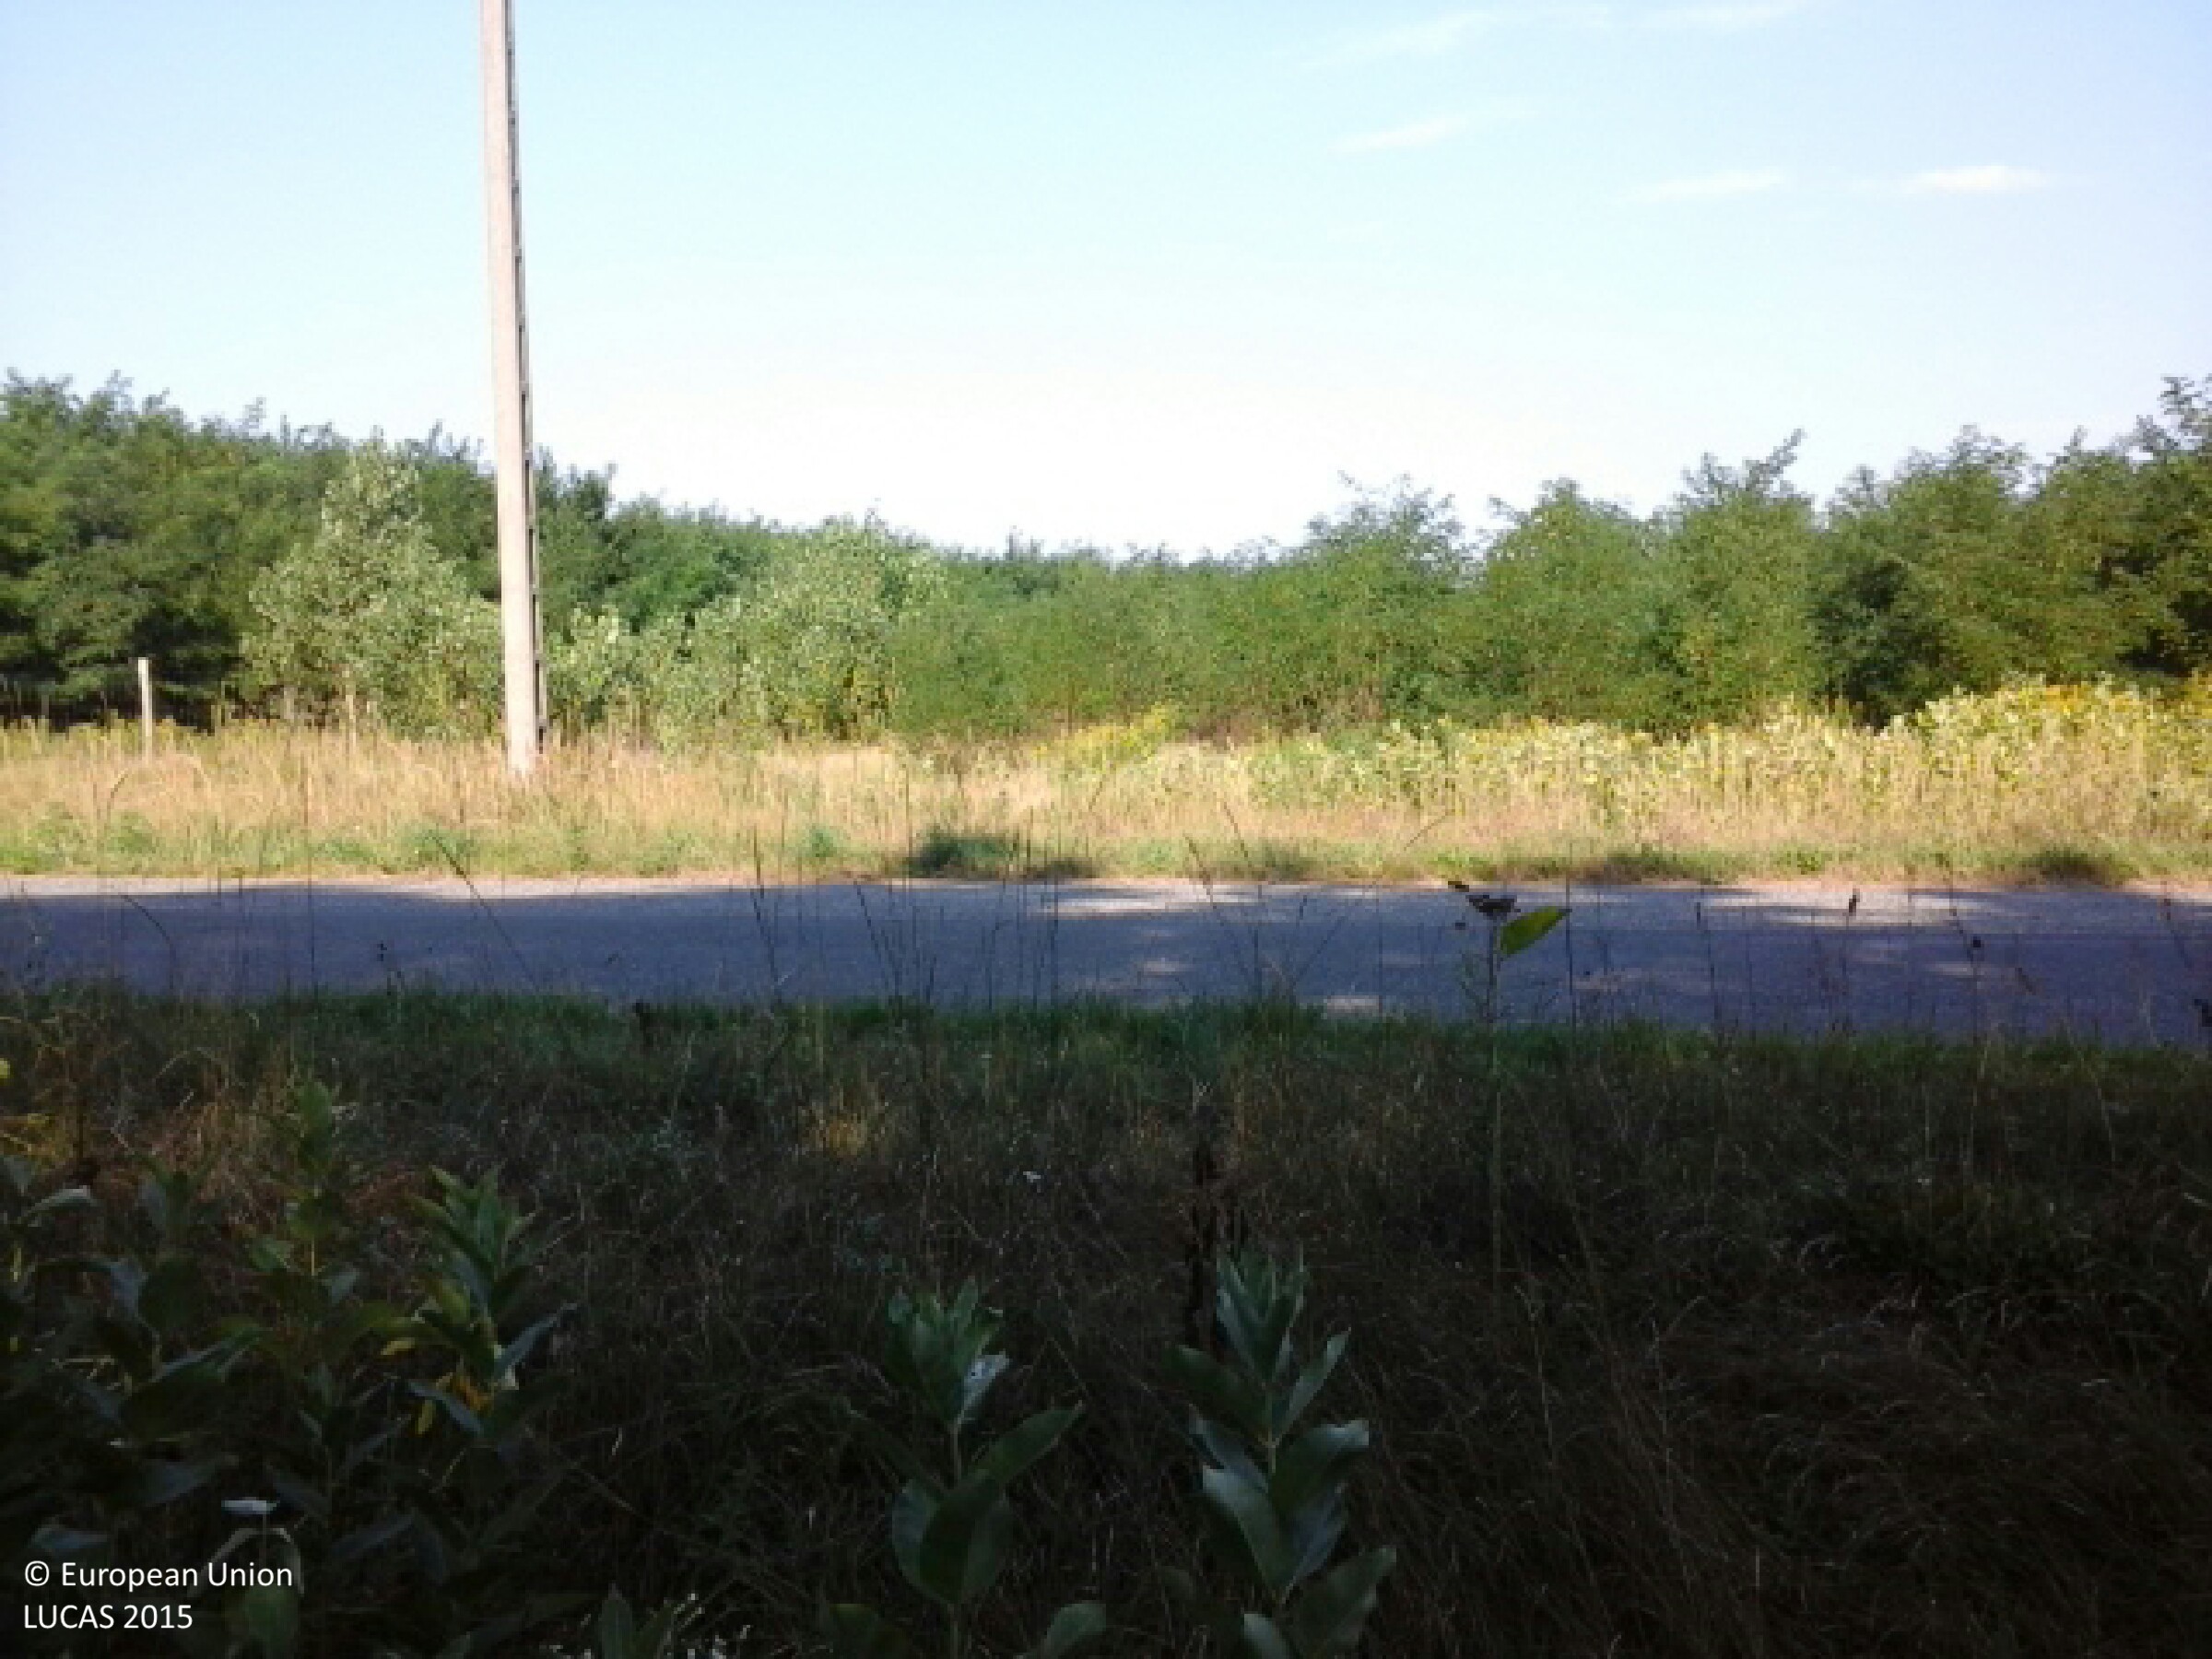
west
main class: Woodland
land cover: Broadleaved woodland
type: exotic forest
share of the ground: > 75 %
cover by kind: broadleaved forest trees 95 %, herbaceous plants 5 %
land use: Forestry
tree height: > 5 m
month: August
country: HU
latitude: 47.5588
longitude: 17.9180
